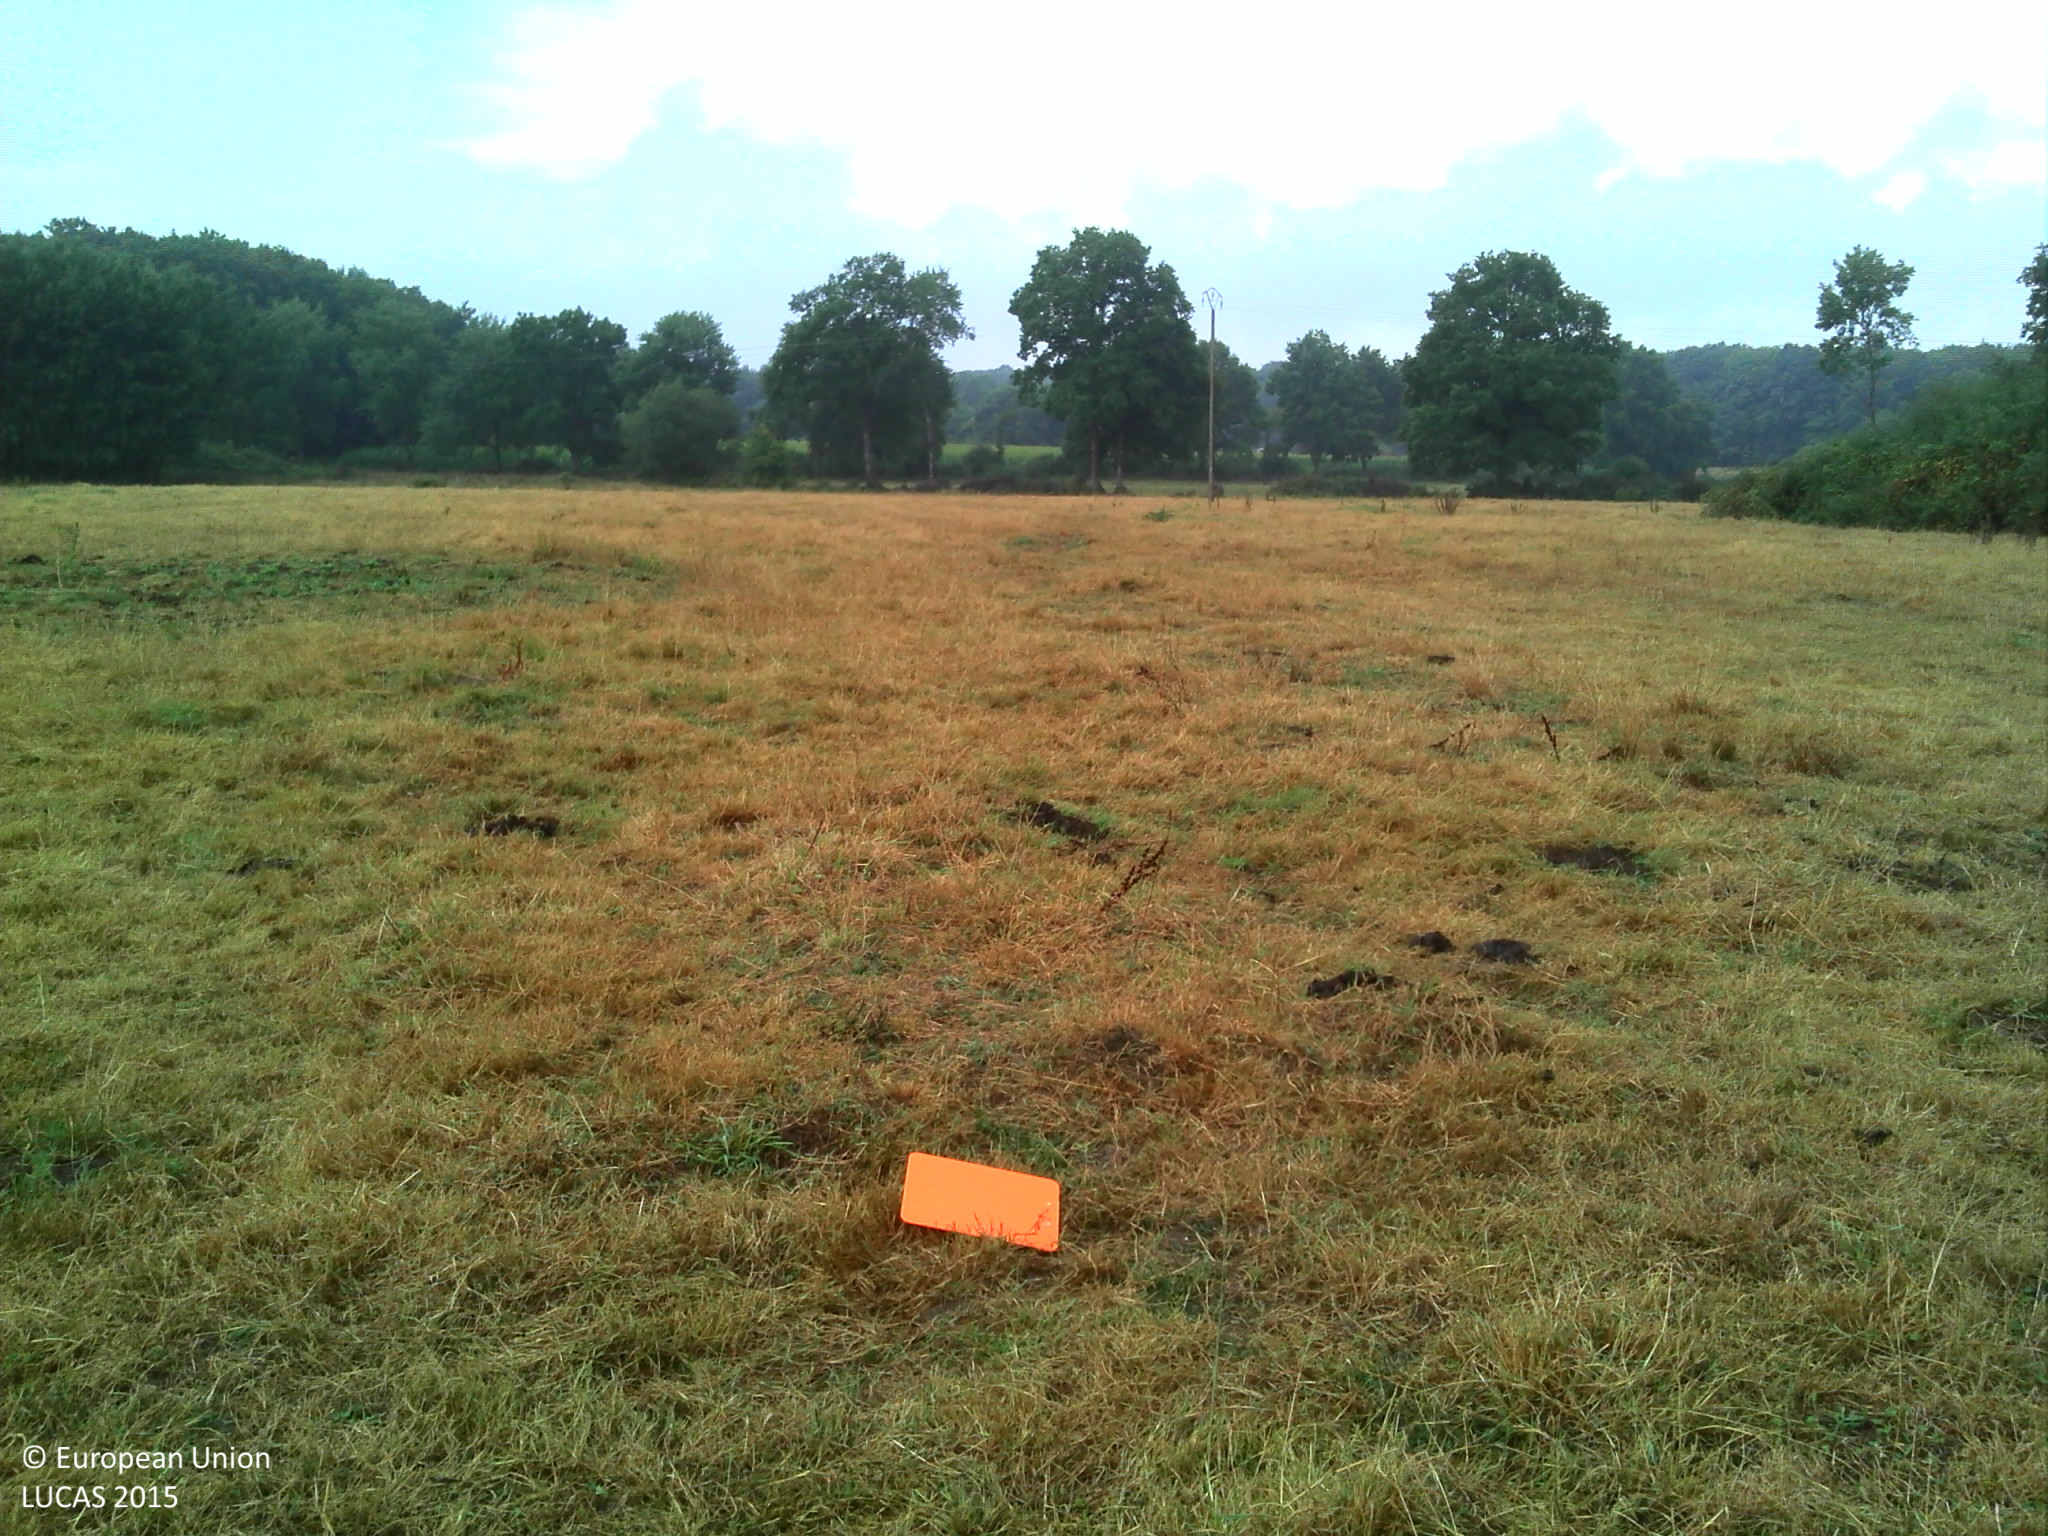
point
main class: Grassland
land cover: Grassland without tree/shrub cover
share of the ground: > 75 %
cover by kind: herbaceous plants 100 %
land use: Agriculture (excluding fallow land and kitchen gardens)
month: August
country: FR
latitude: 46.9142
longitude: -1.6356
